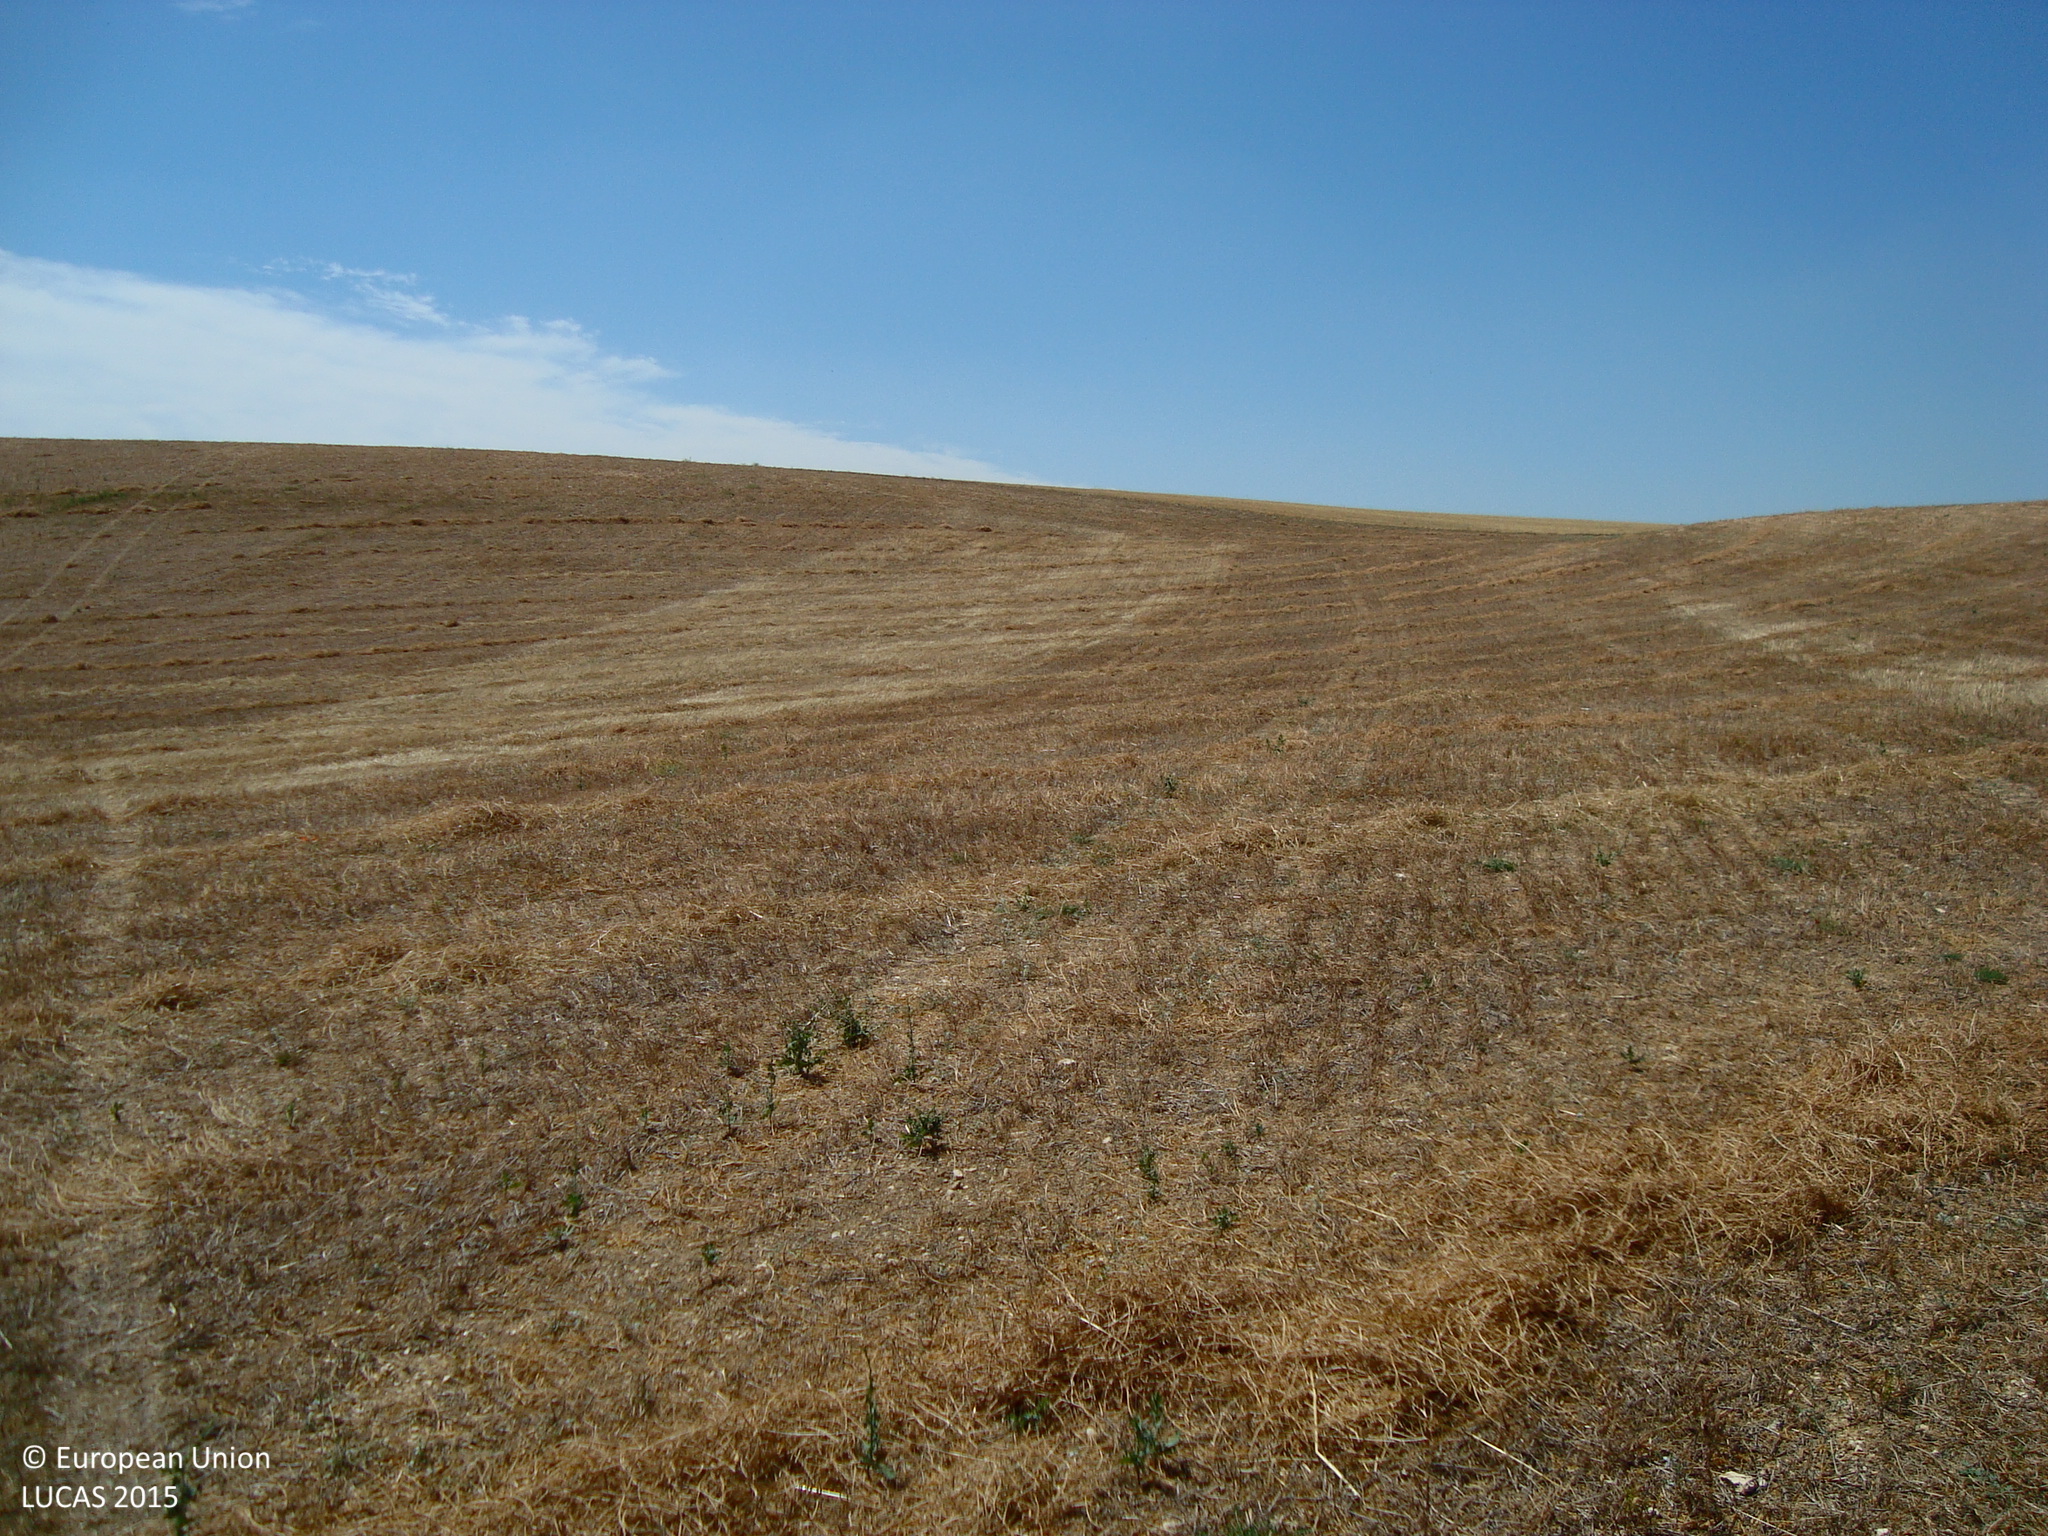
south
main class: Cropland
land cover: Dry pulses
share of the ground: > 75 %
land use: Agriculture (excluding fallow land and kitchen gardens)
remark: Harvested field
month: July
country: ES
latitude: 41.8862
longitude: -3.8076
